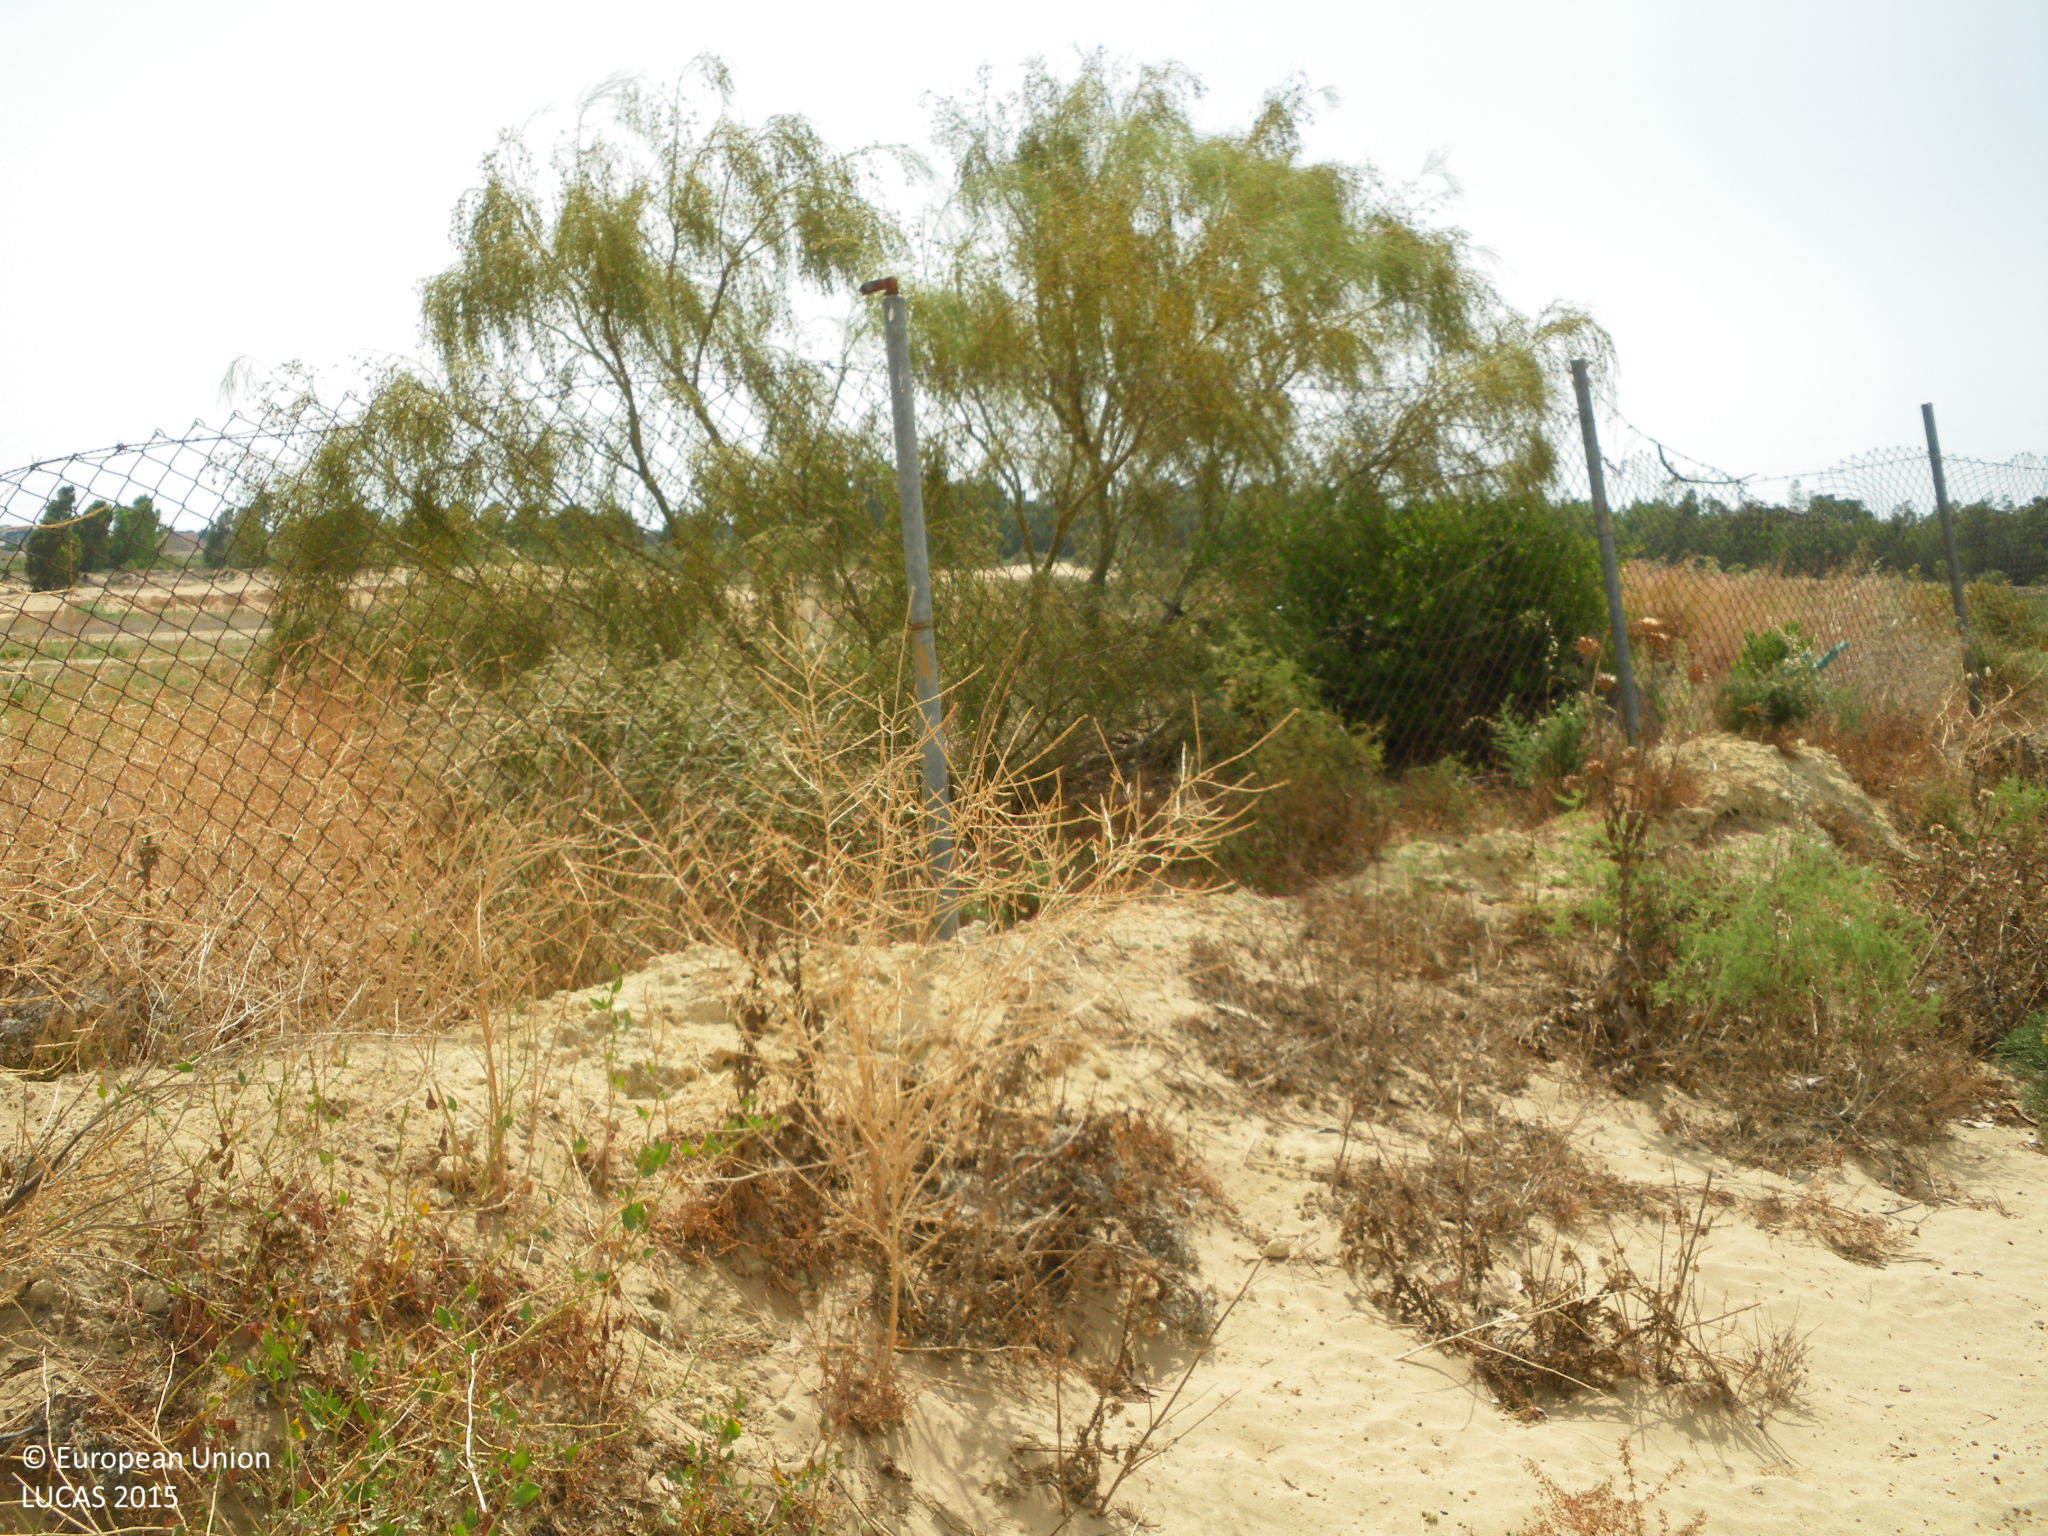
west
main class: Grassland
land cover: Grassland without tree/shrub cover
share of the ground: 10 - 25 %
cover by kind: unconsolidated bare surface 85 %, herbaceous plants 15 %
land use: Semi-natural and natural areas not in use
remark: Clear cut
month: June
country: ES
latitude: 36.6150
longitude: -6.2586
